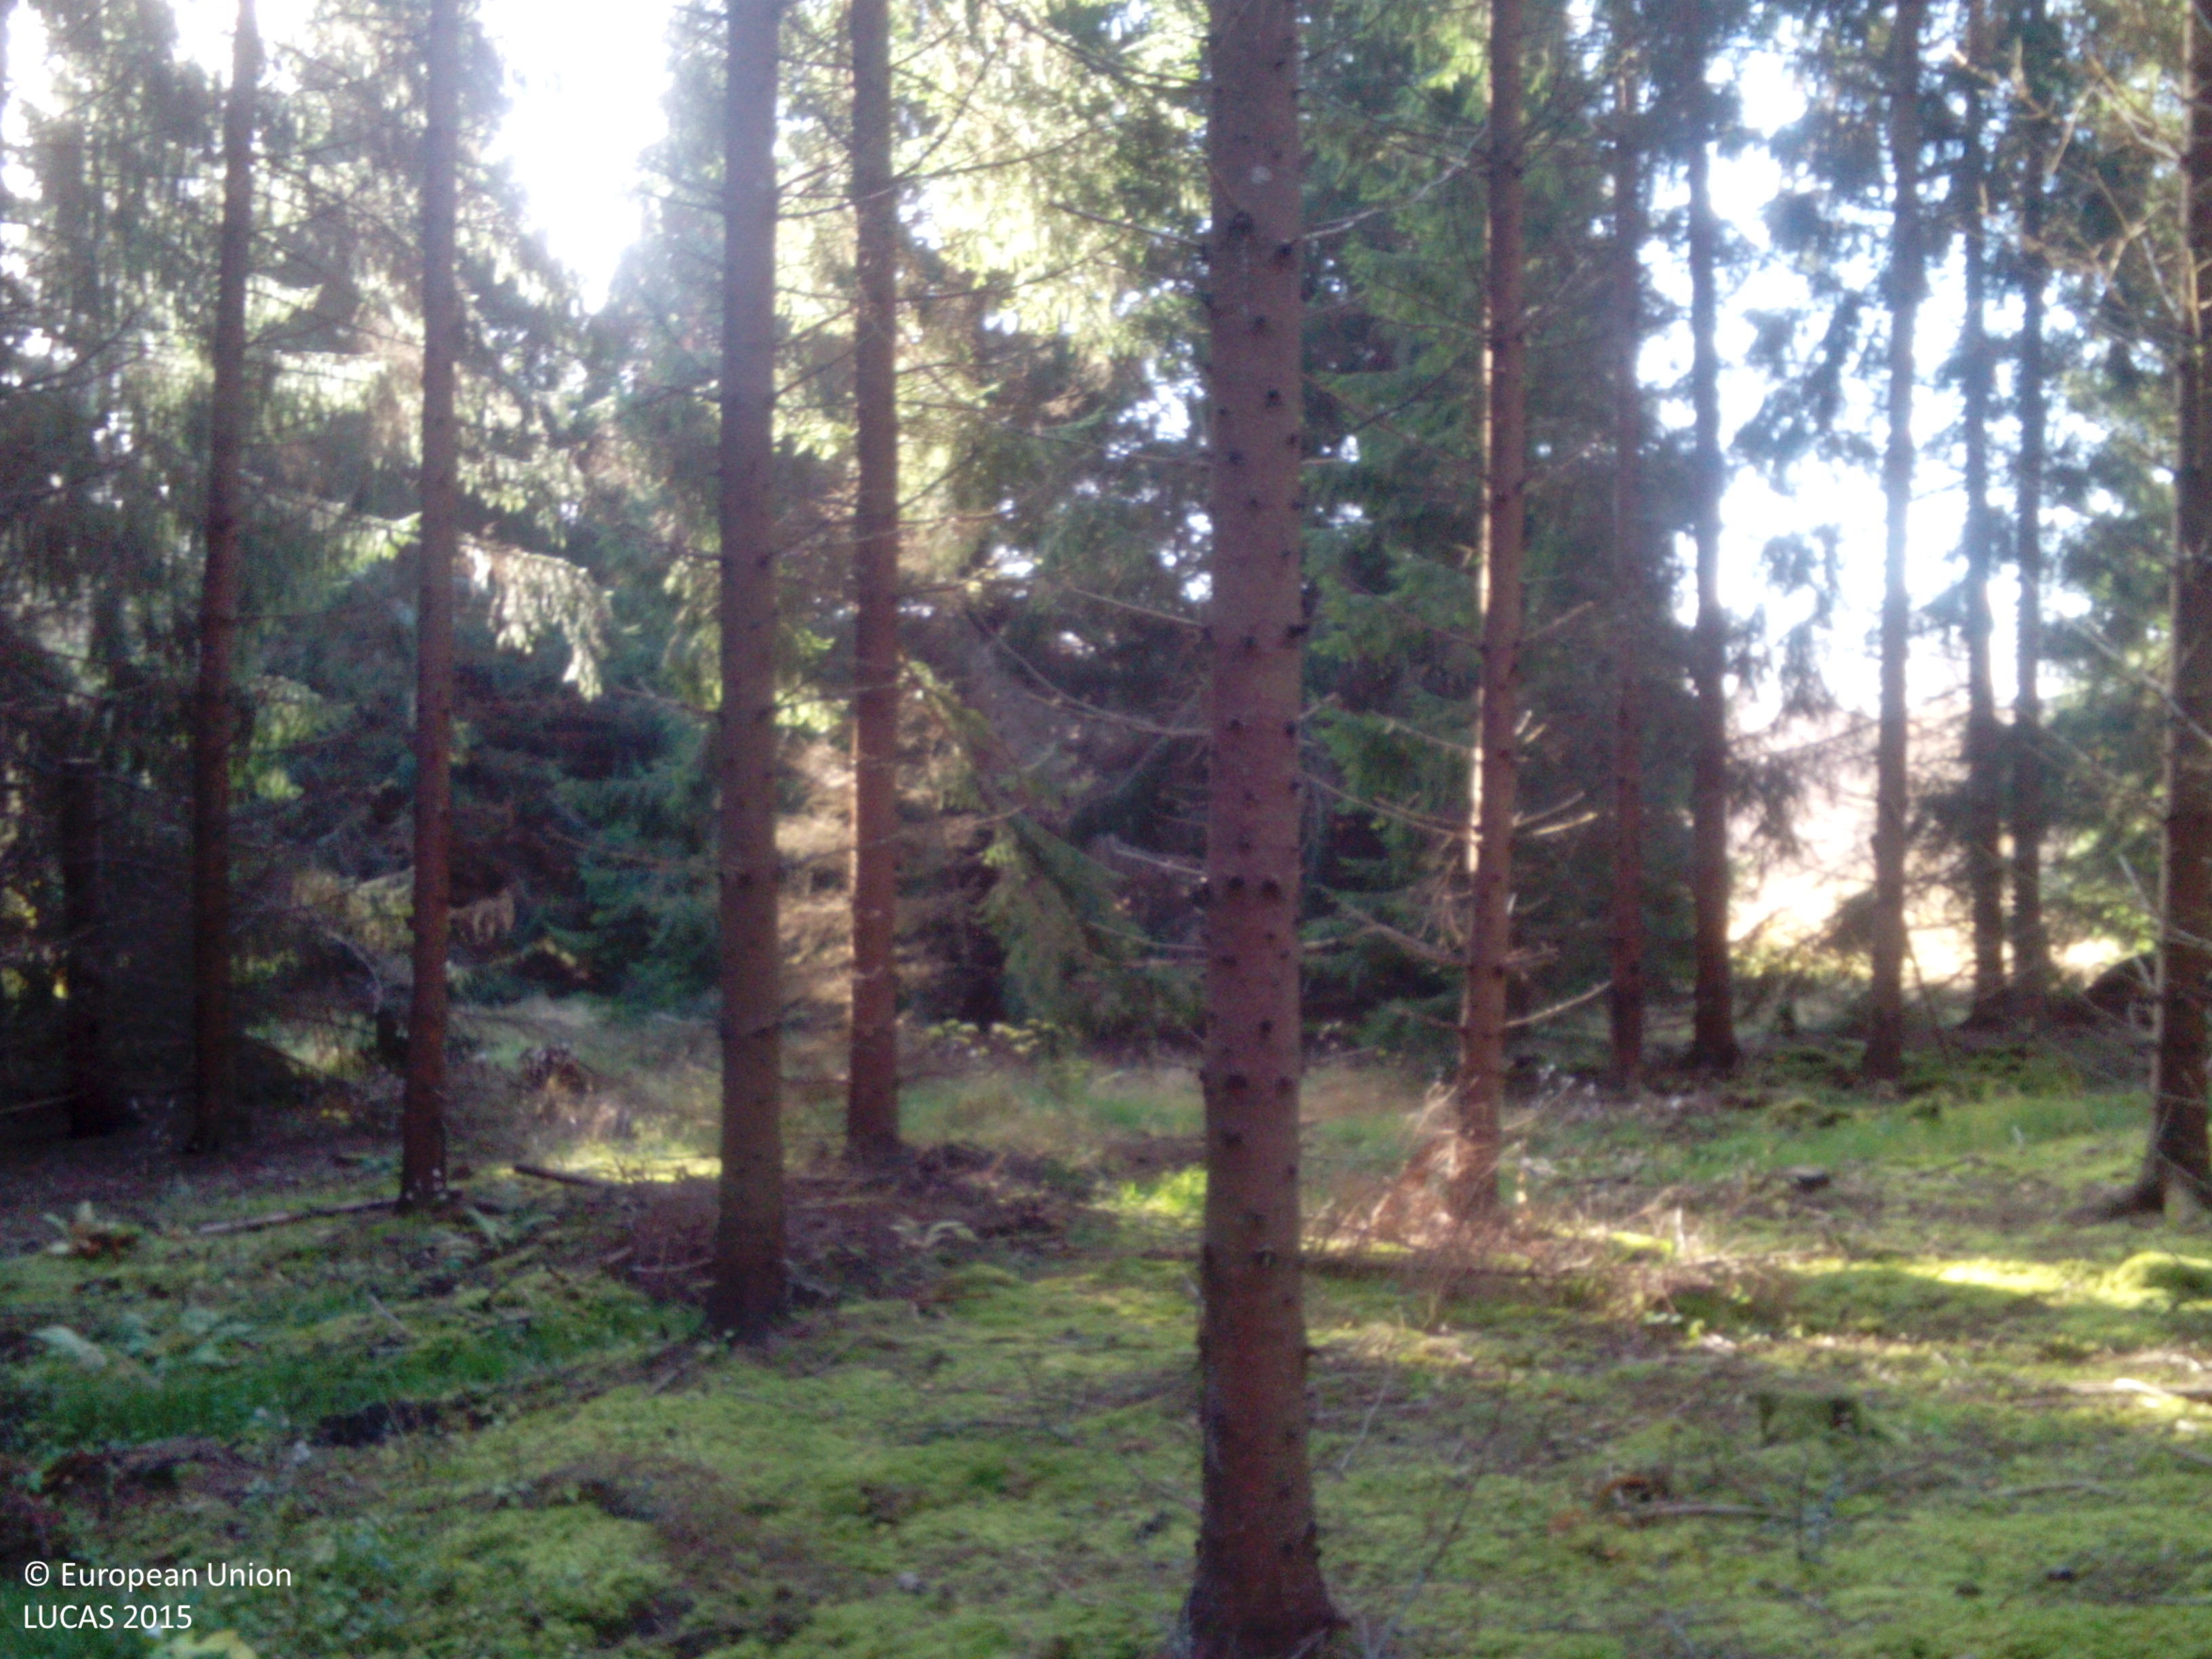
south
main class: Woodland
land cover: Spruce dominated coniferous woodland
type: boreal forest
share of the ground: > 75 %
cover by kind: coniferous forest trees 85 %, lichens and mosses 10 %, herbaceous plants 5 %
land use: Forestry
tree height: > 5 m
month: October
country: SE
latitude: 59.0343
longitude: 16.5635
